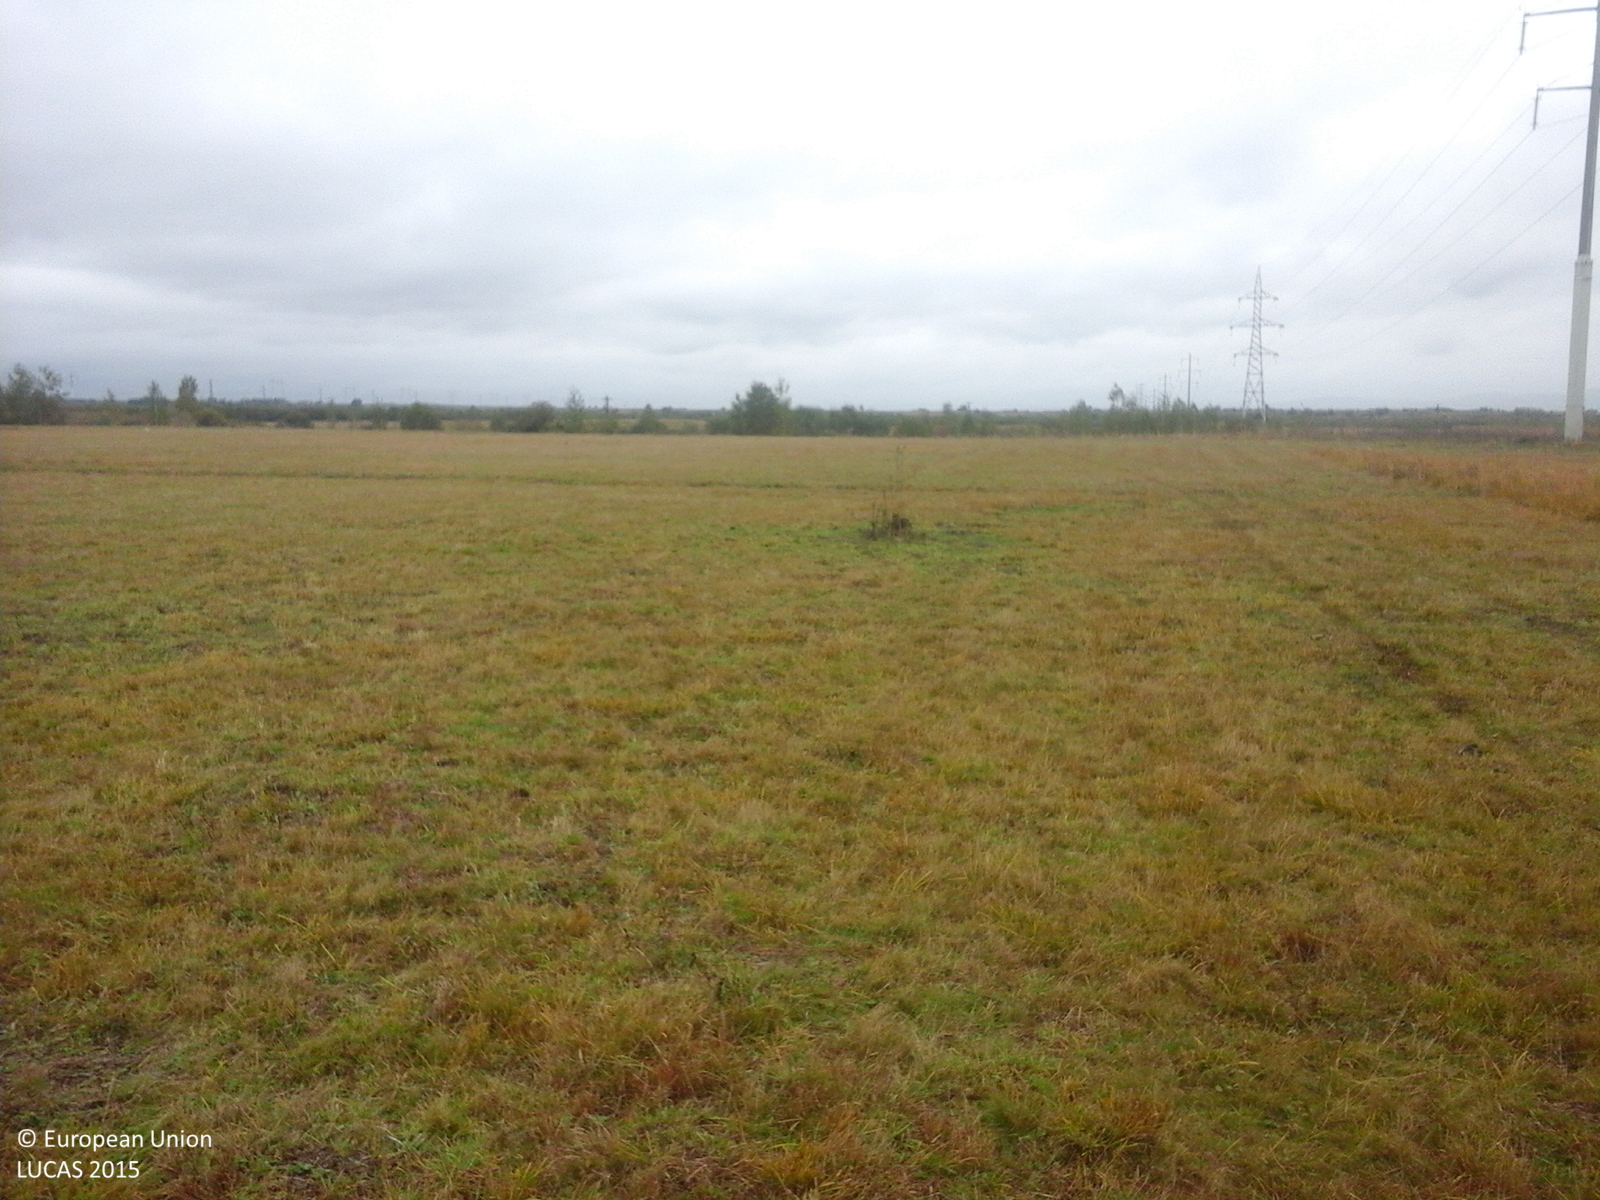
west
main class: Grassland
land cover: Grassland without tree/shrub cover
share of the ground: > 75 %
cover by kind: herbaceous plants 100 %
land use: Agriculture (excluding fallow land and kitchen gardens)
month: October
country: RO
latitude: 45.7459
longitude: 24.5951
